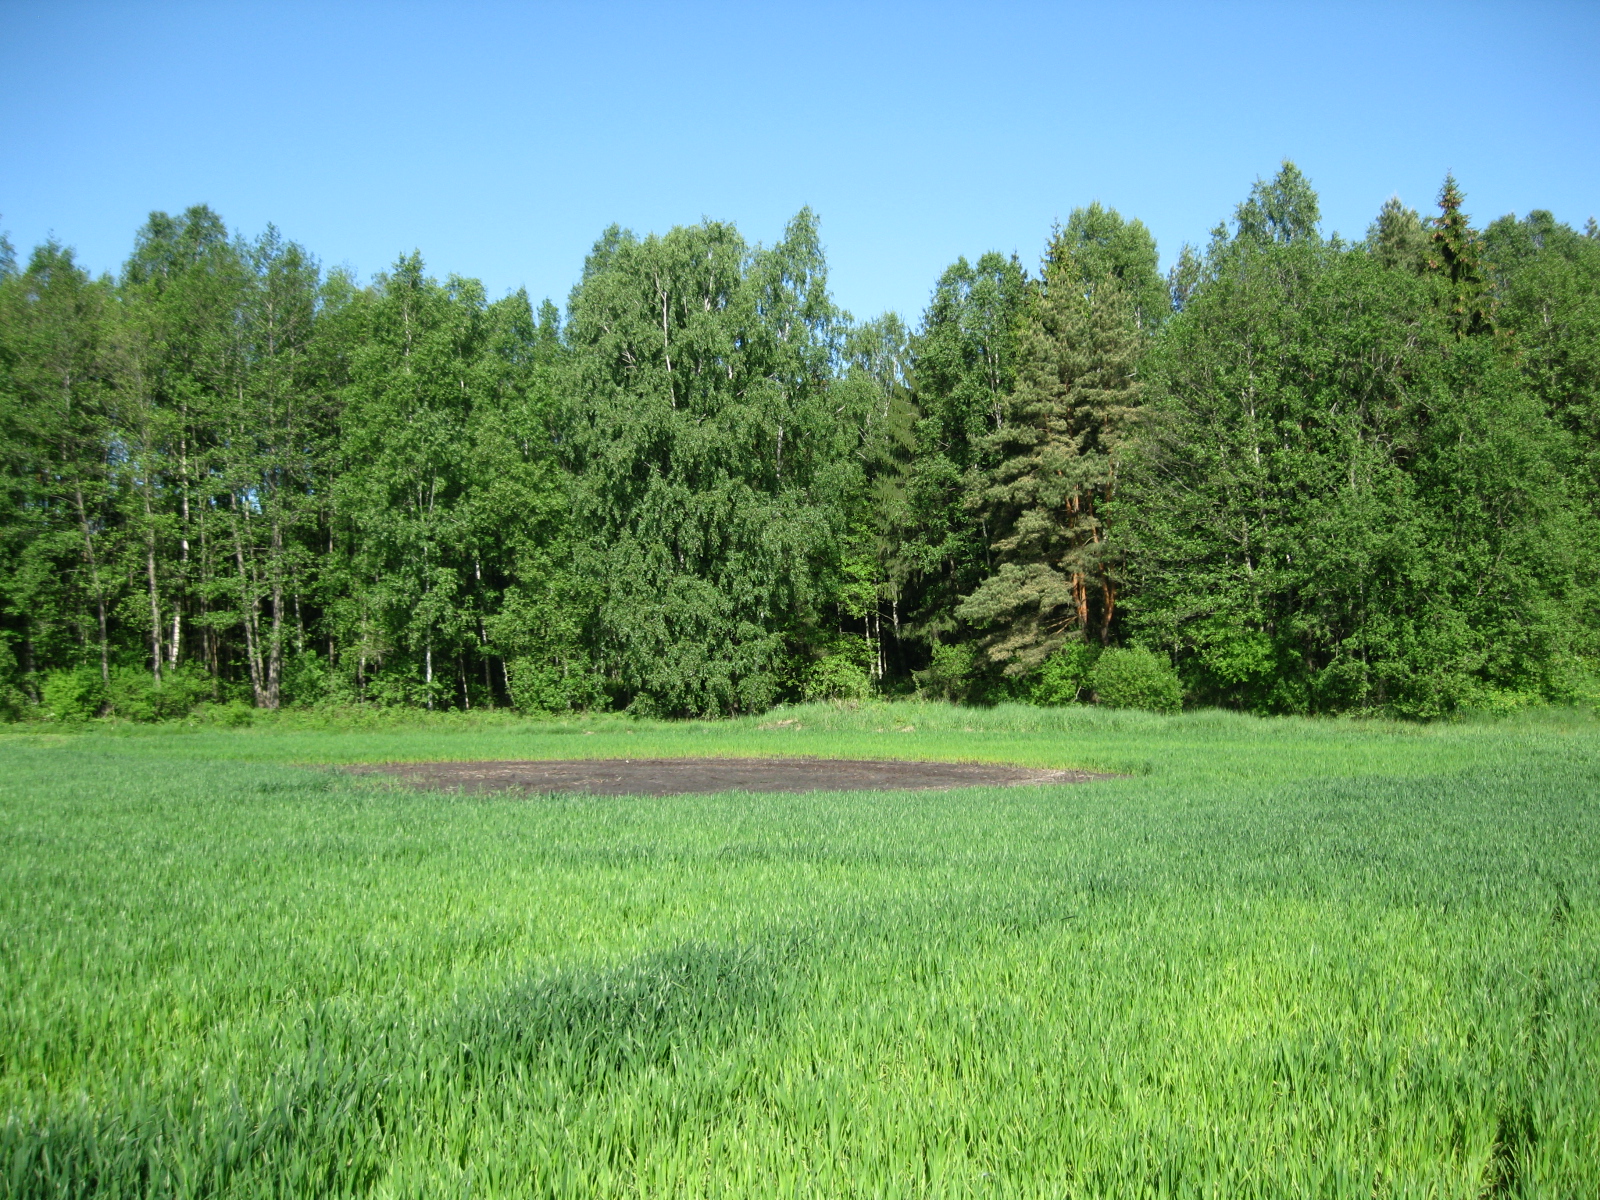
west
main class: Cropland
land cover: Common wheat
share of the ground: > 75 %
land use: Agriculture (excluding fallow land and kitchen gardens)
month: May
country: LT
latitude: 55.8359
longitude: 24.3215
